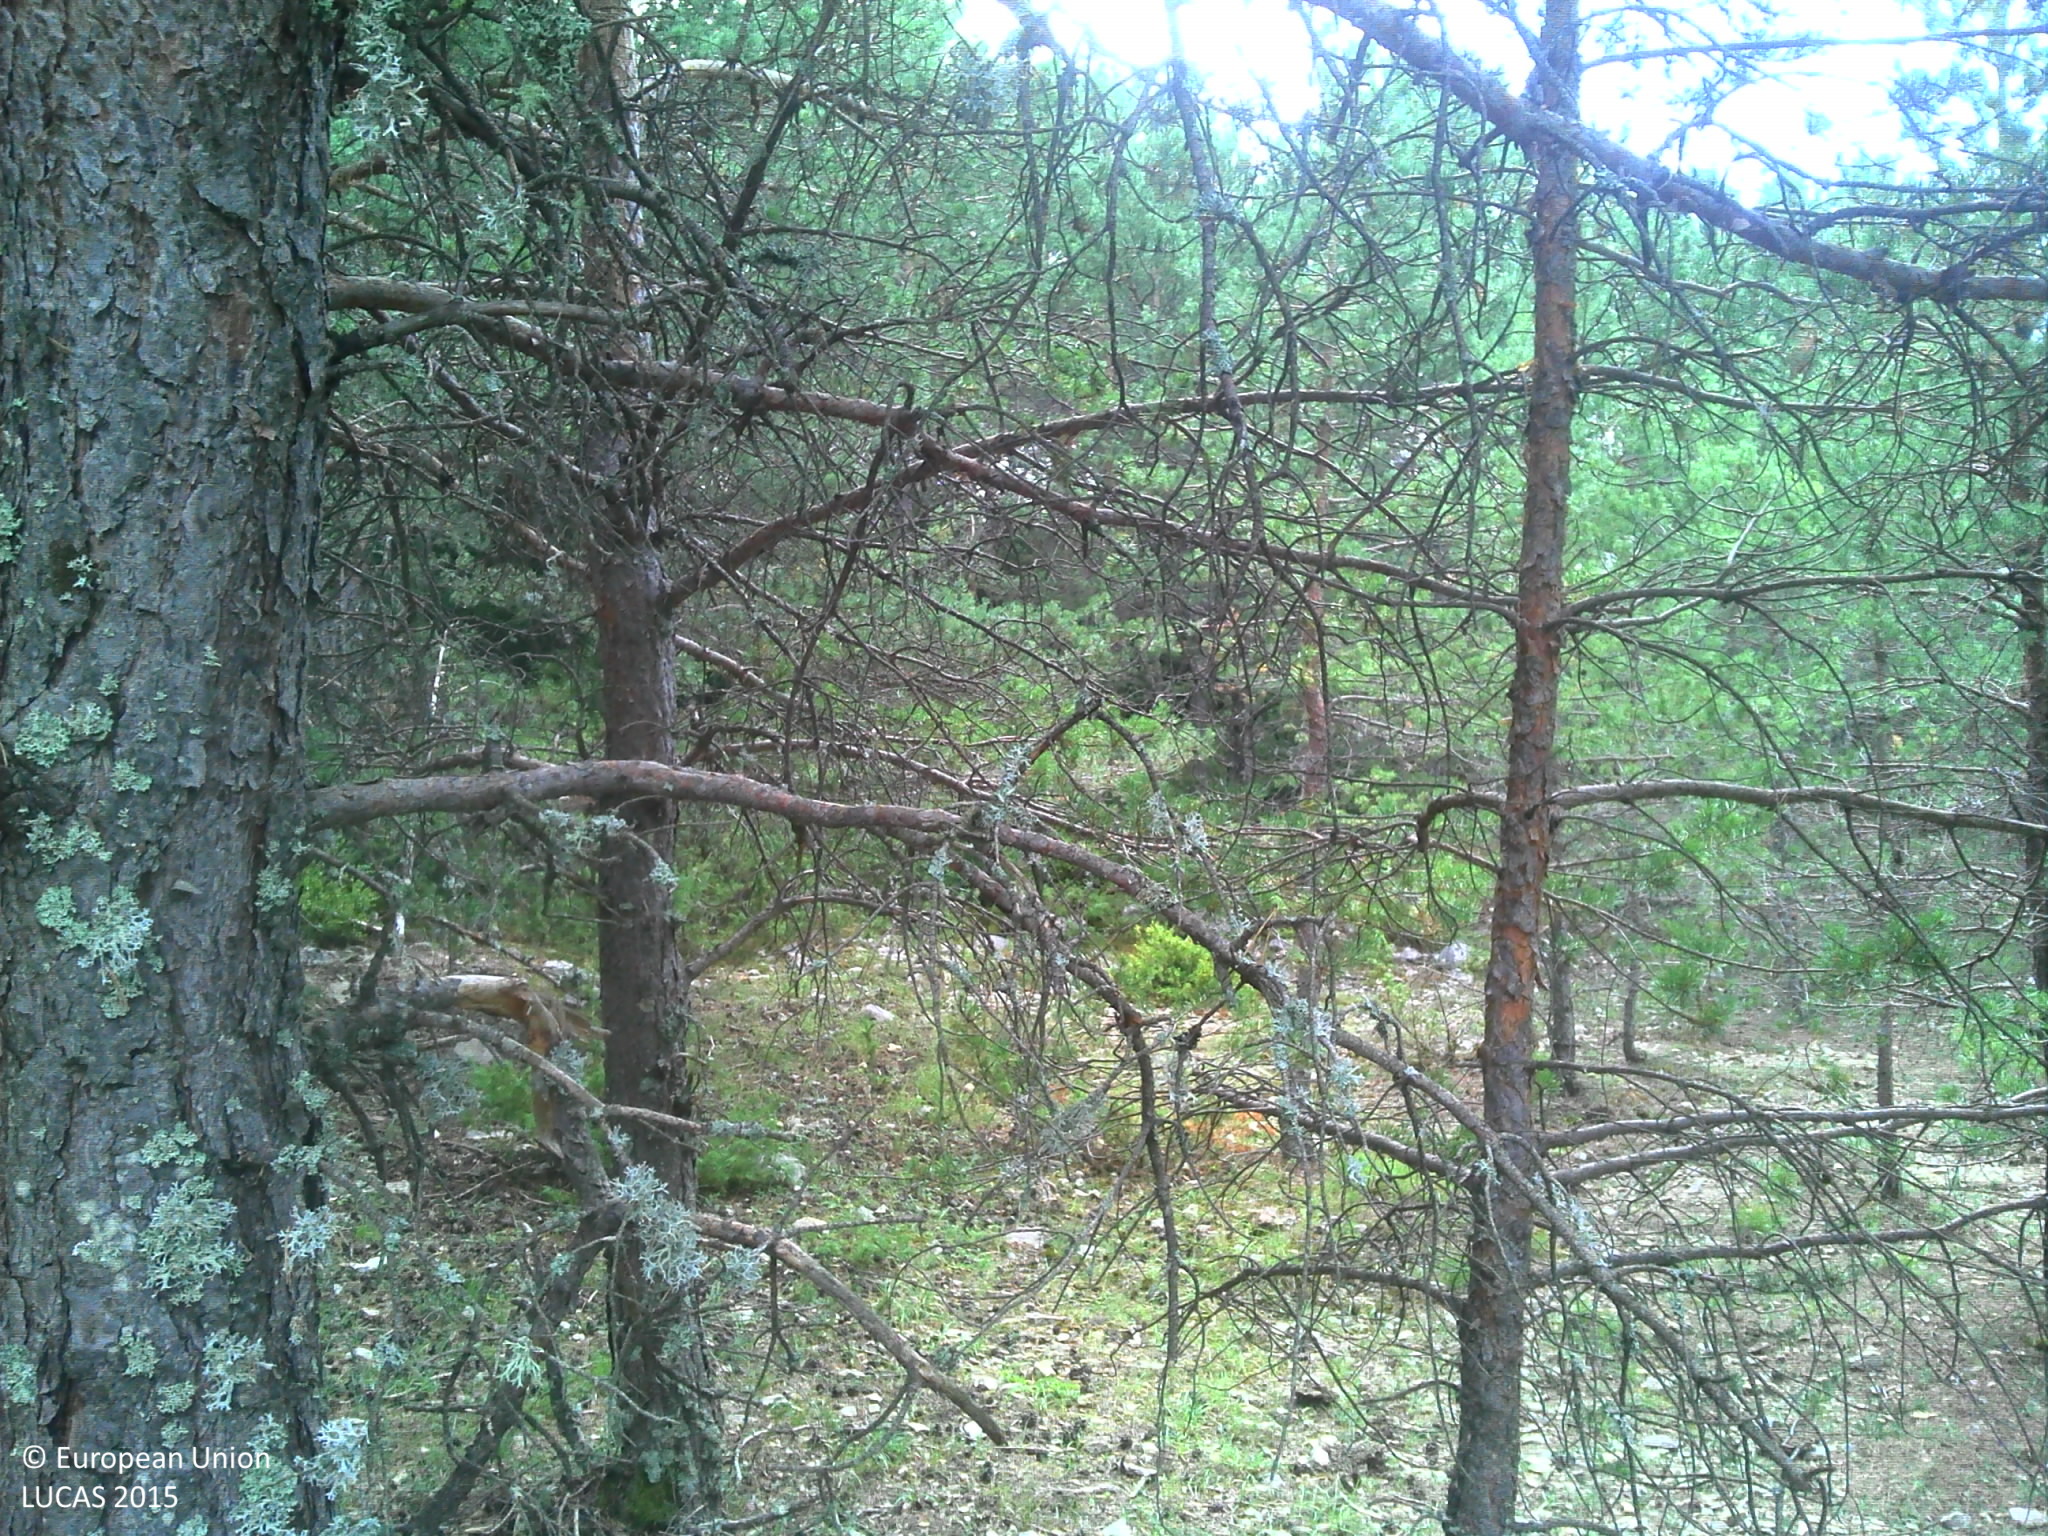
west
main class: Woodland
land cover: Pine dominated coniferous woodland
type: alpine coniferous forest
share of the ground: 50 - 75 %
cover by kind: coniferous forest trees 90 %, consolidated bare surface 10 %
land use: Semi-natural and natural areas not in use
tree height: > 5 m
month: August
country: FR
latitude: 44.0679
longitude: 6.2994
